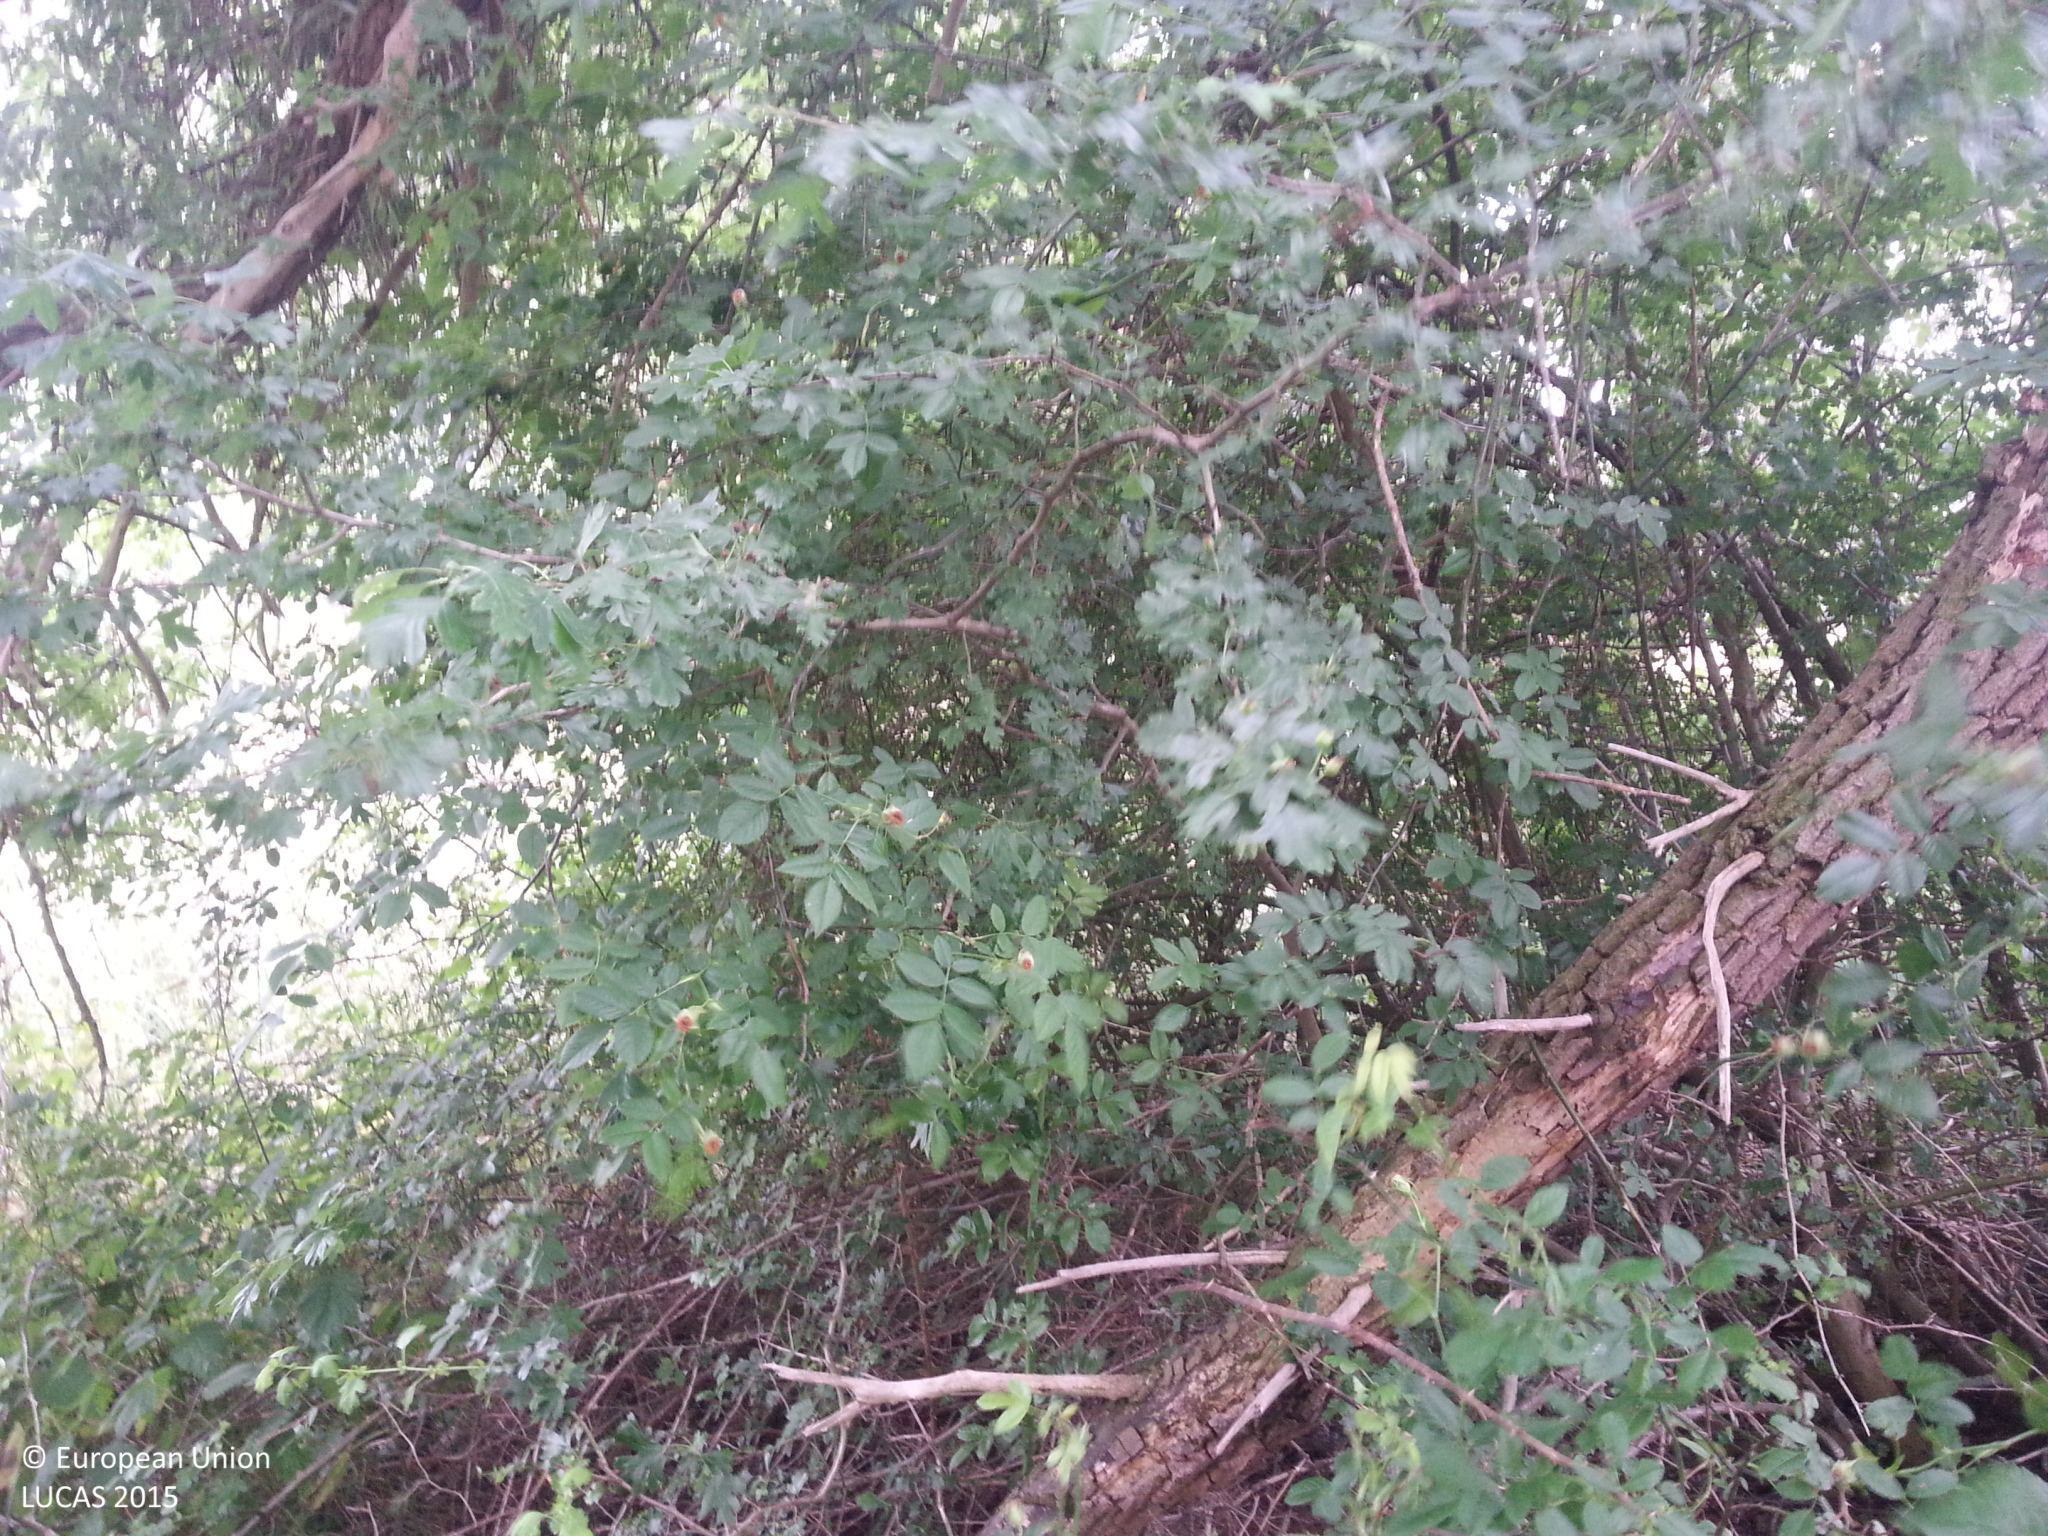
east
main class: Woodland
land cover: Broadleaved woodland
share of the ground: > 75 %
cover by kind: broadleaved forest trees 95 %, herbaceous plants 5 %
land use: Forestry
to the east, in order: Broadleaved woodland; Grassland without tree/shrub cover; Ditches and canals; Grassland without tree/shrub cover; Broadleaved woodland; Common wheat
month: July
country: DE
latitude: 53.8229
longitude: 11.5943
